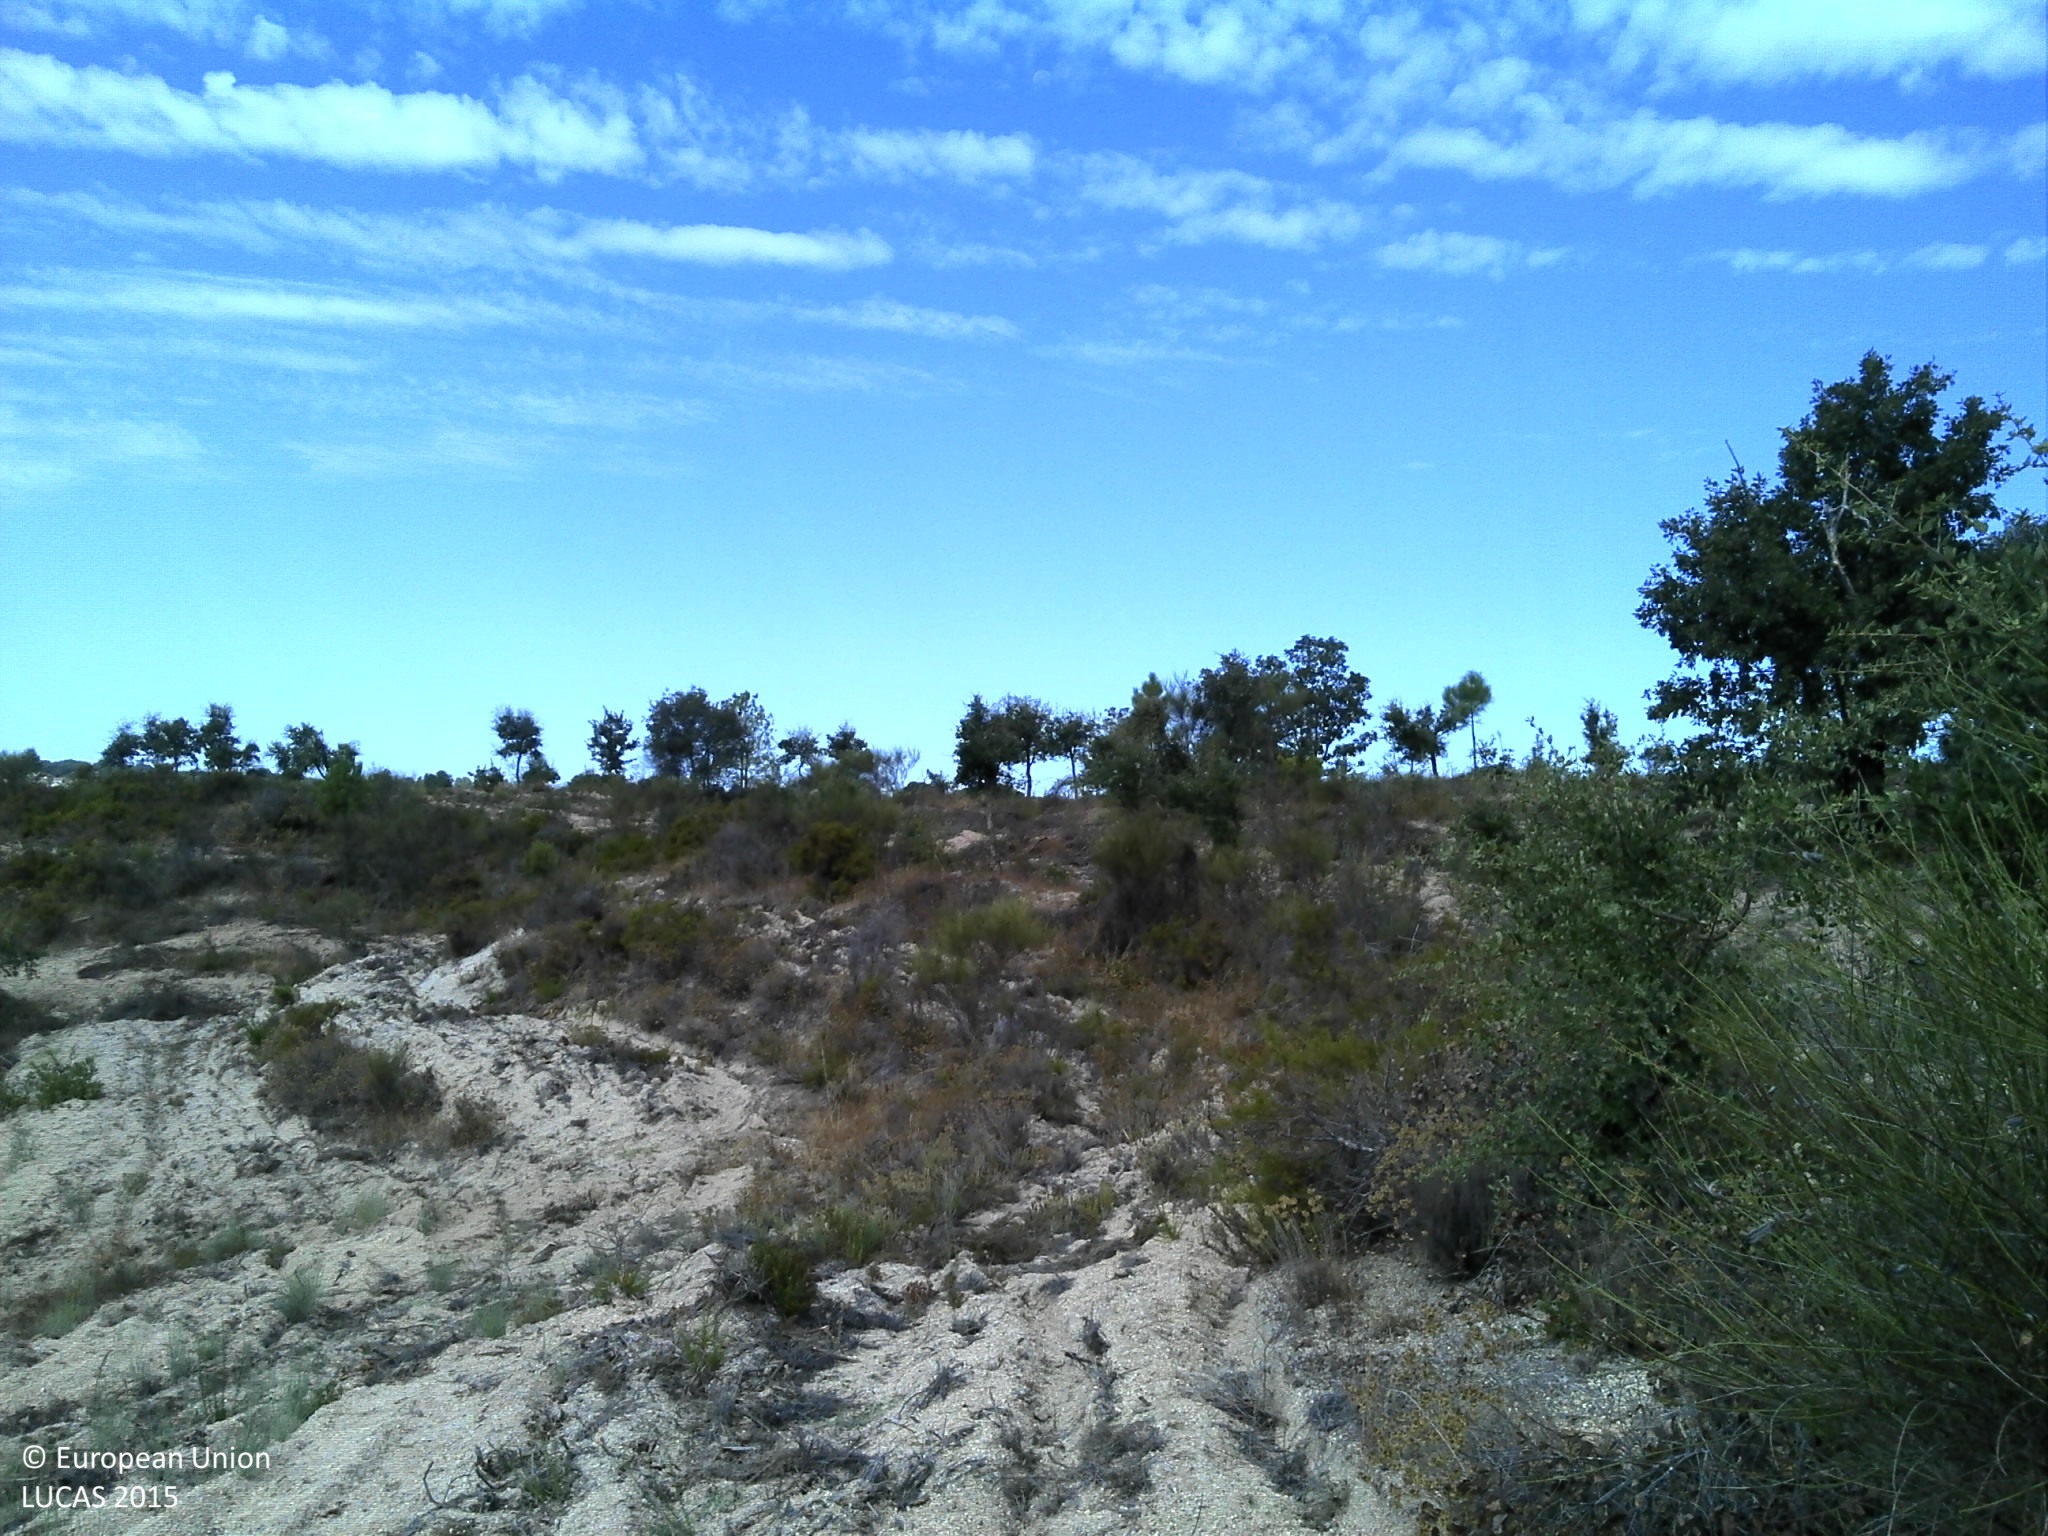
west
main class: Woodland
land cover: Broadleaved woodland
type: broadleaved evergreen forest
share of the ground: 10 - 25 %
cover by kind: unconsolidated bare surface 90 %, broadleaved forest trees 10 %
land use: Forestry
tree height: < 5 m
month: August
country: PT
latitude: 39.4905
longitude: -7.7138
